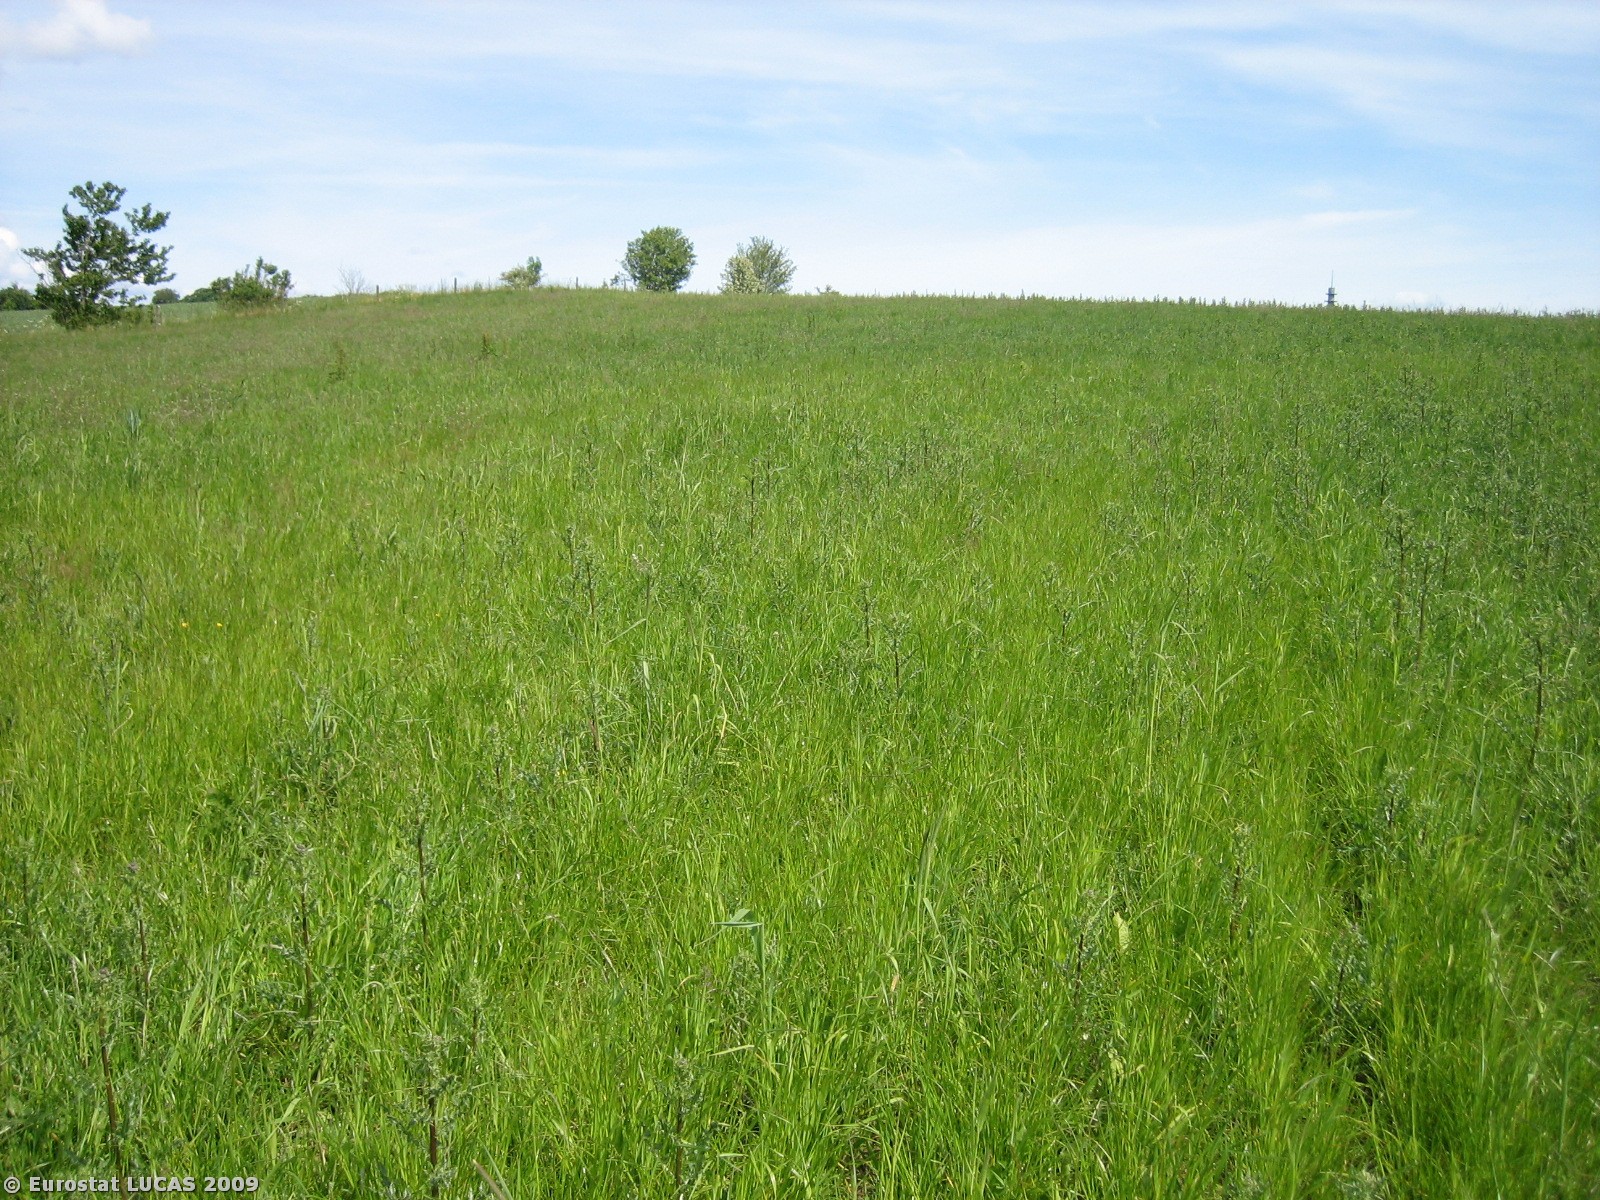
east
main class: Grassland
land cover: Grassland without tree/shrub cover
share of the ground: > 75 %
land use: Agriculture (excluding fallow land and kitchen gardens)
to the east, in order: Grassland without tree/shrub cover; Fences; Grassland with sparse tree/shrub cover; Common wheat
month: June
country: DK
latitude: 56.1875
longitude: 9.7586
